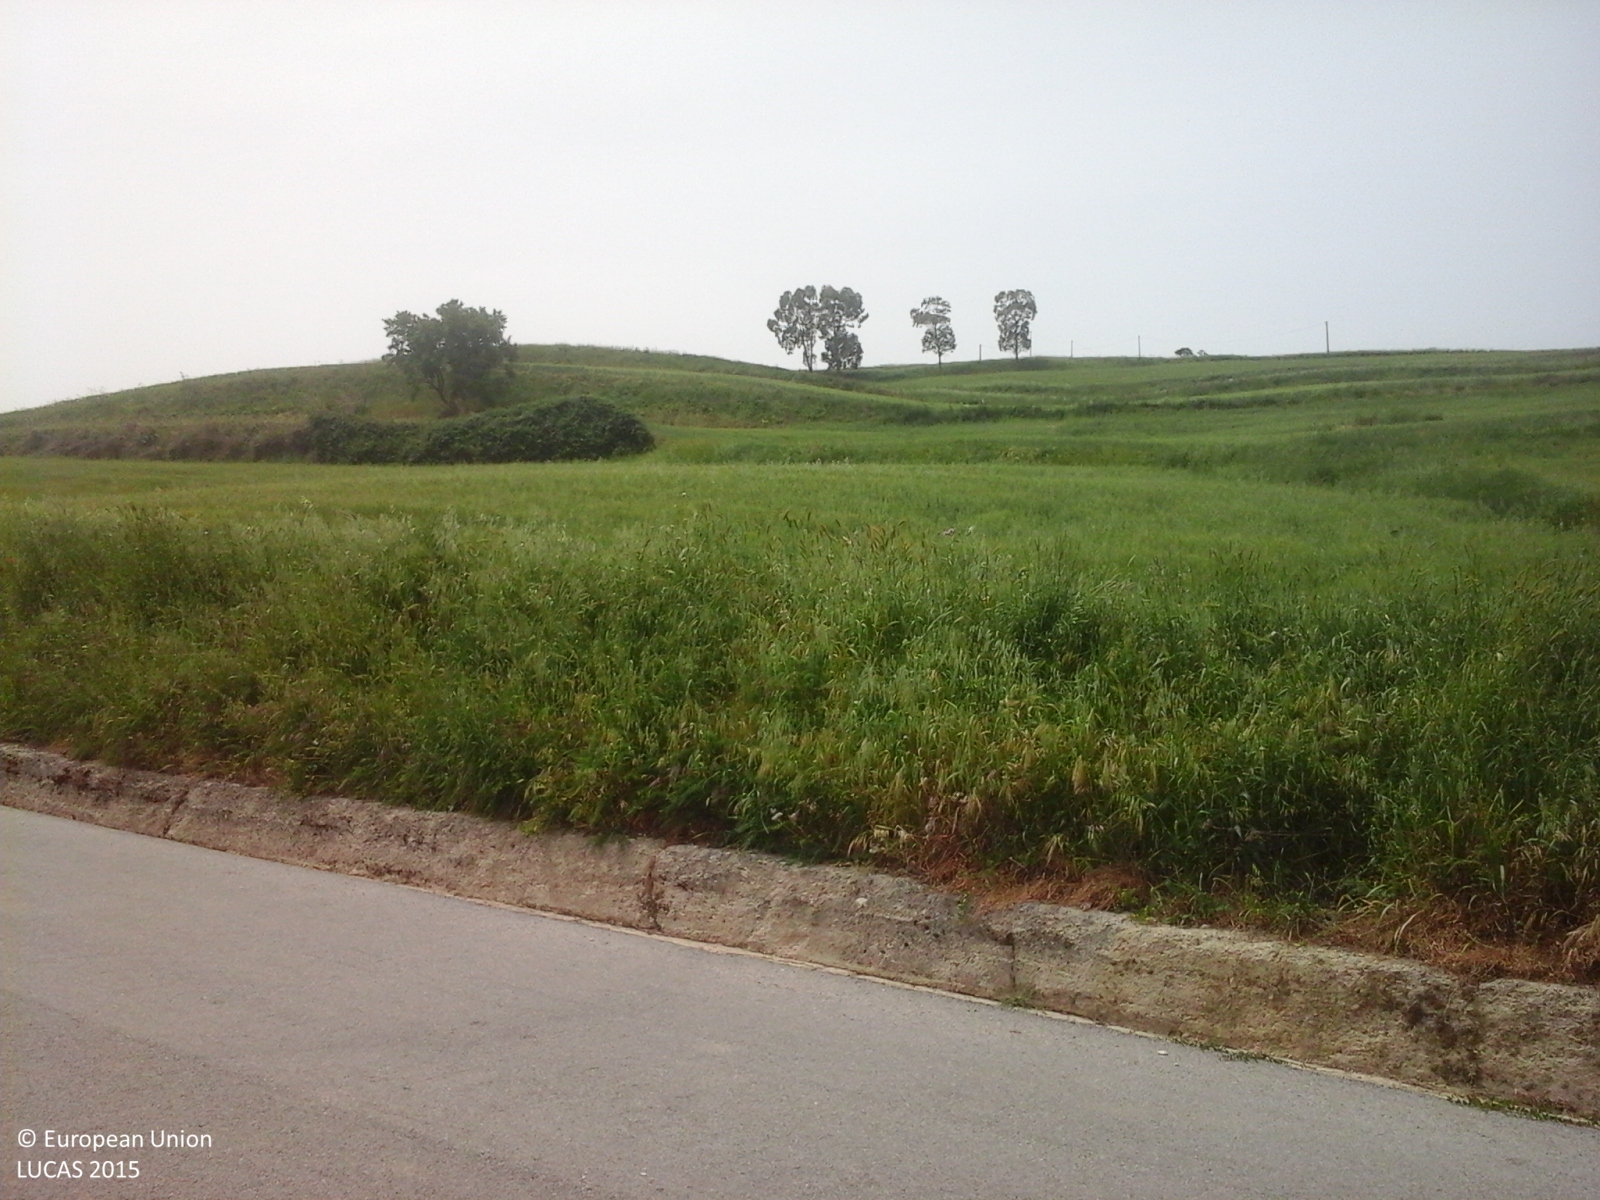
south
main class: Cropland
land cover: Durum wheat
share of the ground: > 75 %
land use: Agriculture (excluding fallow land and kitchen gardens)
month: May
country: IT
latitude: 37.7342
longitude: 13.5933
